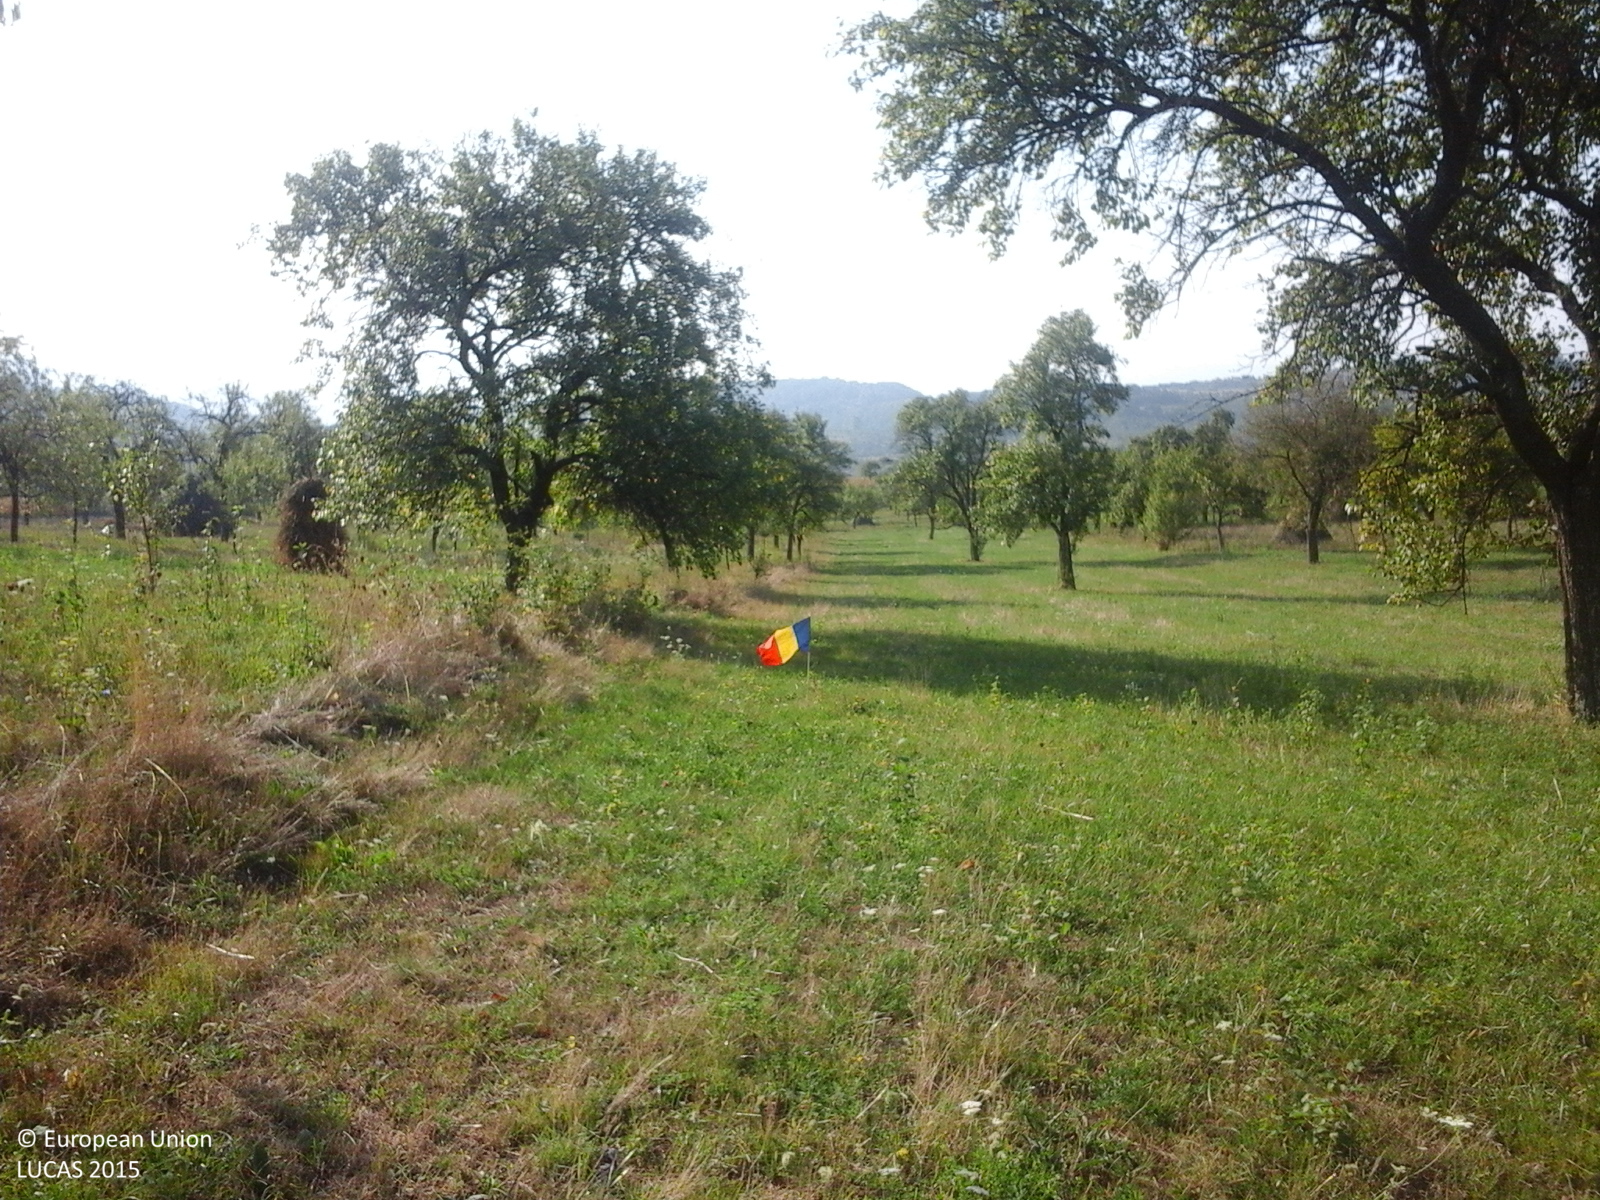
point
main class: Cropland
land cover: Other fruit trees and berries
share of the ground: 50 - 75 %
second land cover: Grassland without tree/shrub cover
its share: > 75 %
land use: Agriculture (excluding fallow land and kitchen gardens)
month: September
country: RO
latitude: 45.0946
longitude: 22.2762
